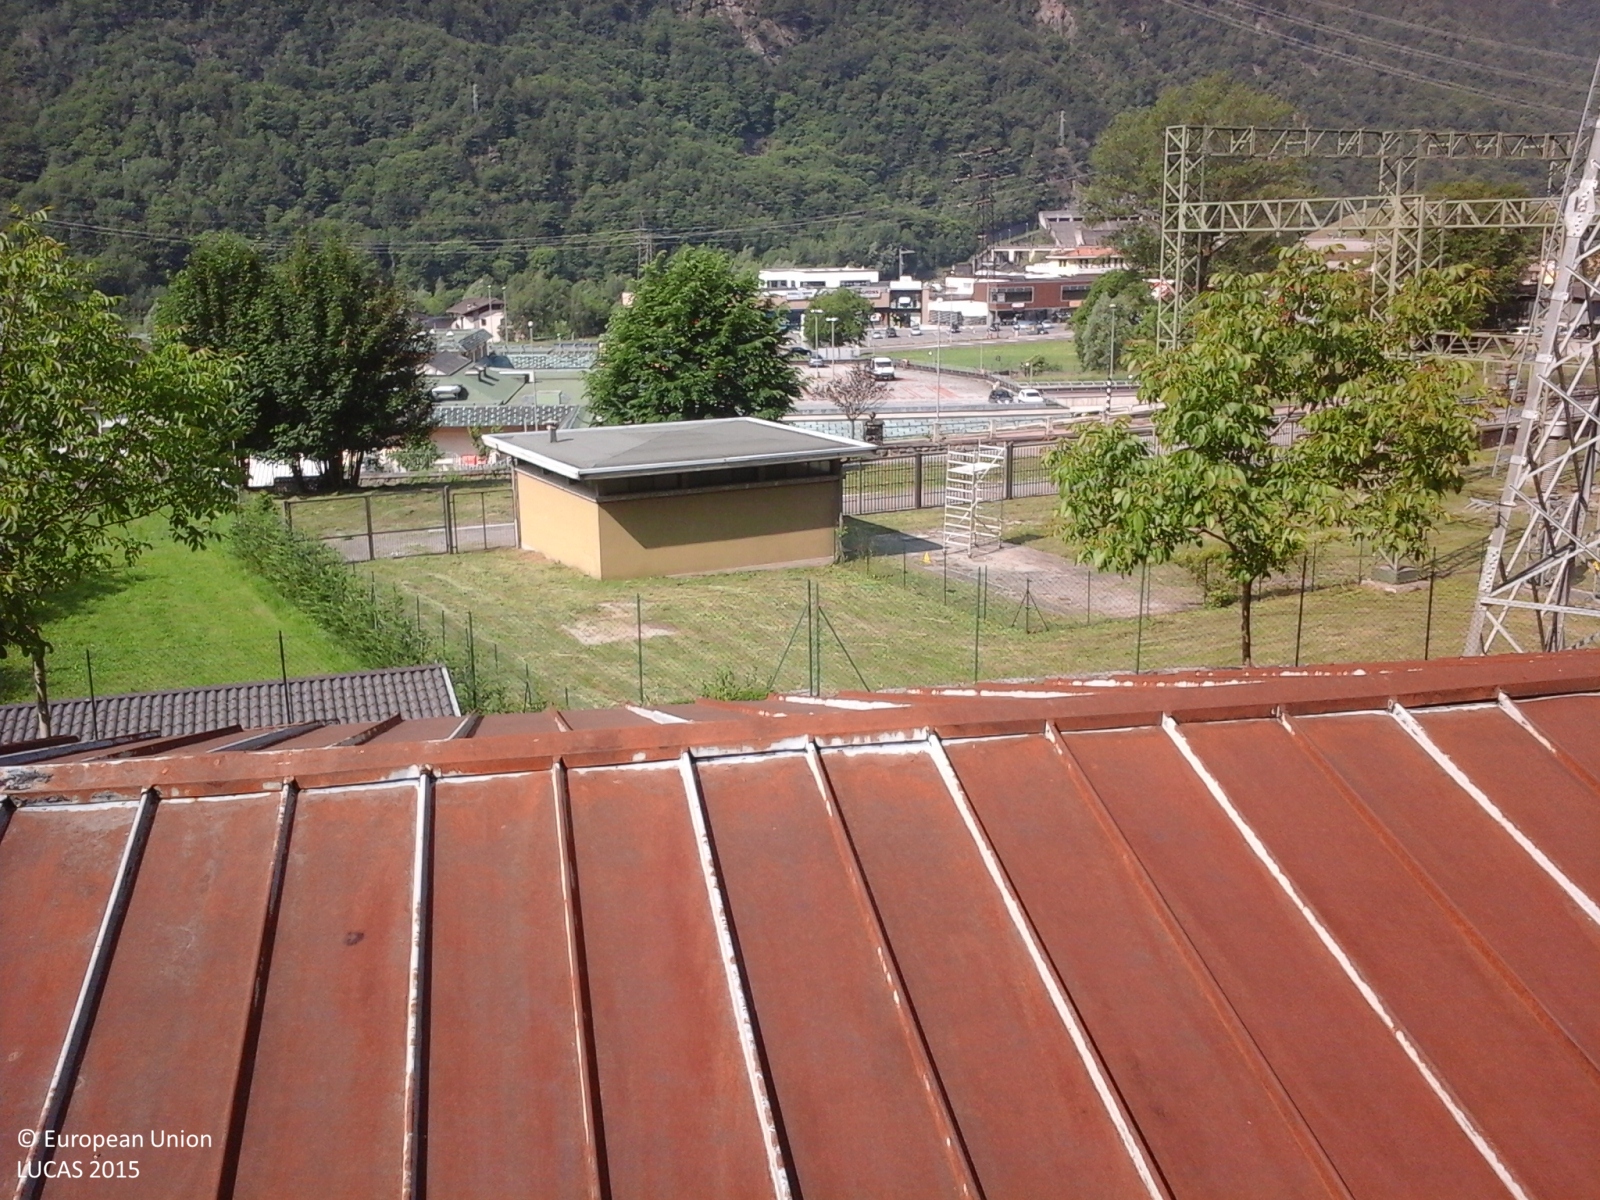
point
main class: Grassland
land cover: Grassland without tree/shrub cover
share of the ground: > 75 %
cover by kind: herbaceous plants 100 %
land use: Energy production
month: June
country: IT
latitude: 46.1705
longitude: 10.3492
